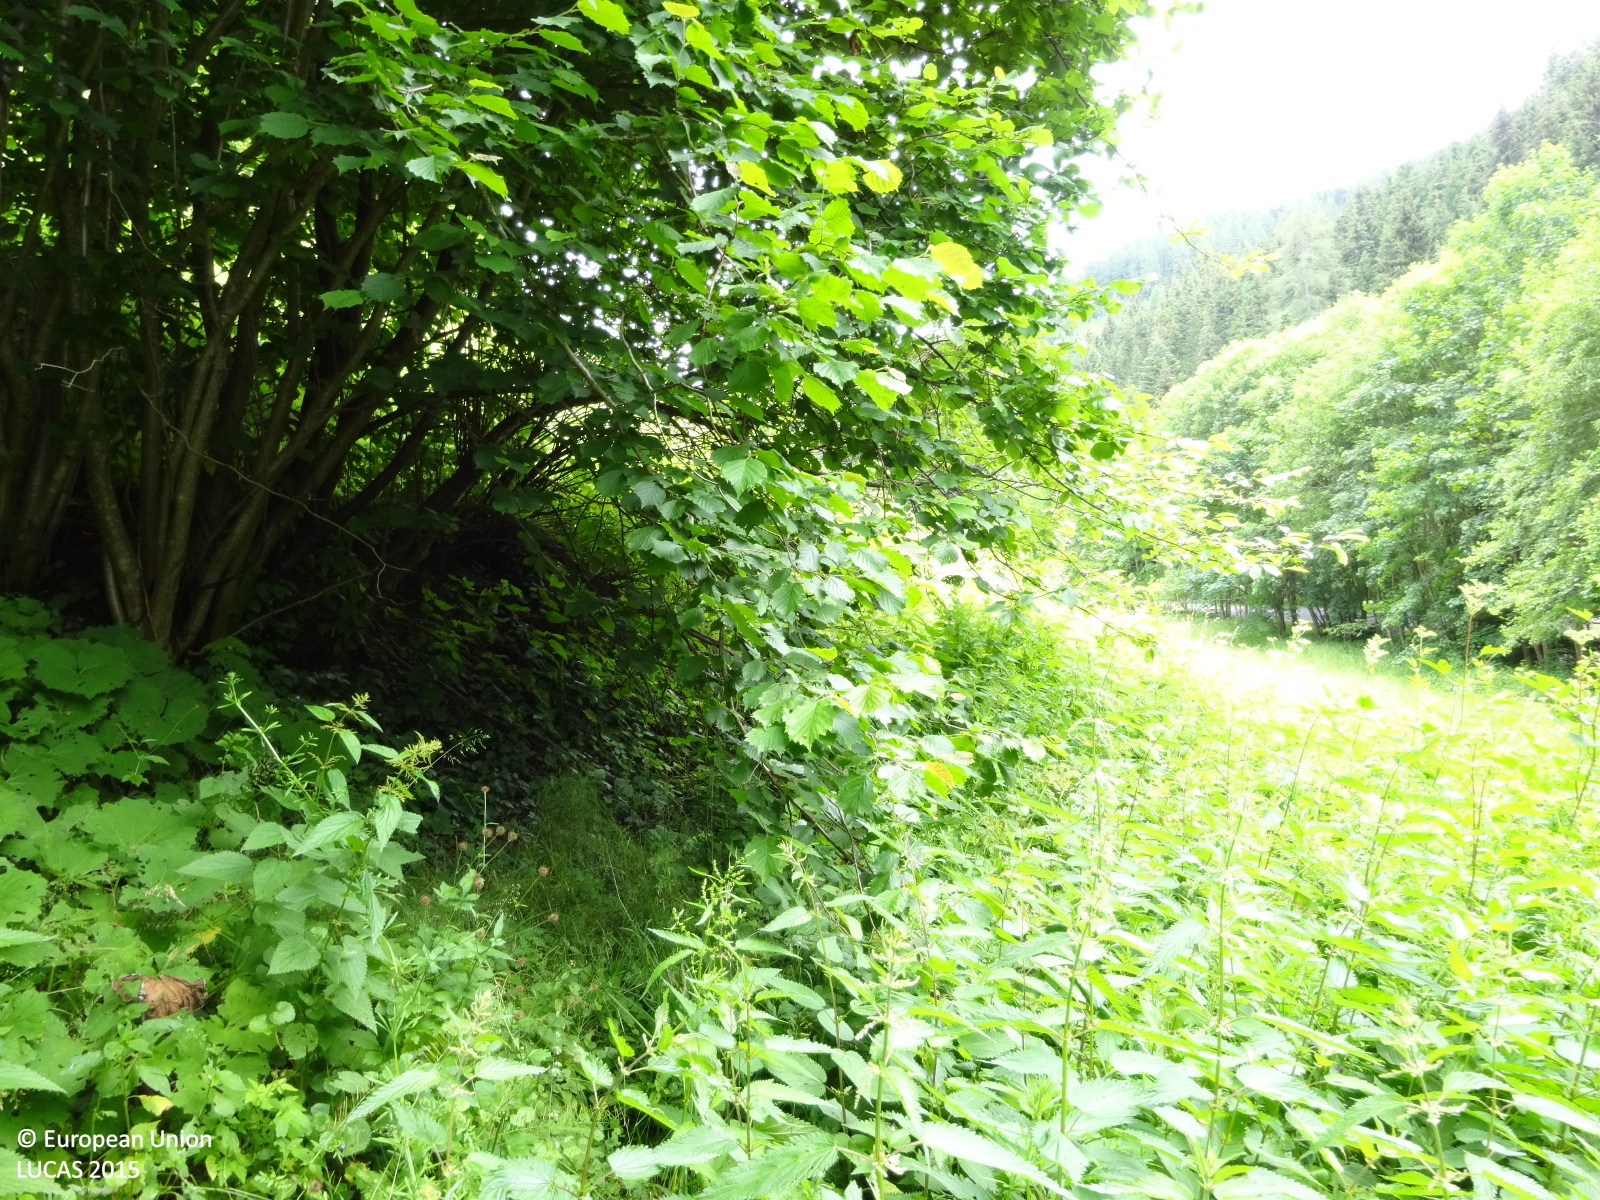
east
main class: Grassland
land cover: Grassland without tree/shrub cover
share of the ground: > 75 %
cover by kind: herbaceous plants 100 %
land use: Agriculture (excluding fallow land and kitchen gardens)
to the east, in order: Grassland without tree/shrub cover; Shrubland without tree cover; Grassland without tree/shrub cover; Broadleaved woodland; Fences; Grassland without tree/shrub cover; Fences; Grassland without tree/shrub cover; Fences; Broadleaved woodland; Fences; Paved roads, cycling and walking lanes; Grassland without tree/shrub cover; Fences; Broadleaved woodland; Fences; Grassland without tree/shrub cover
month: June
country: AT
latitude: 47.5887
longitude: 15.7063
